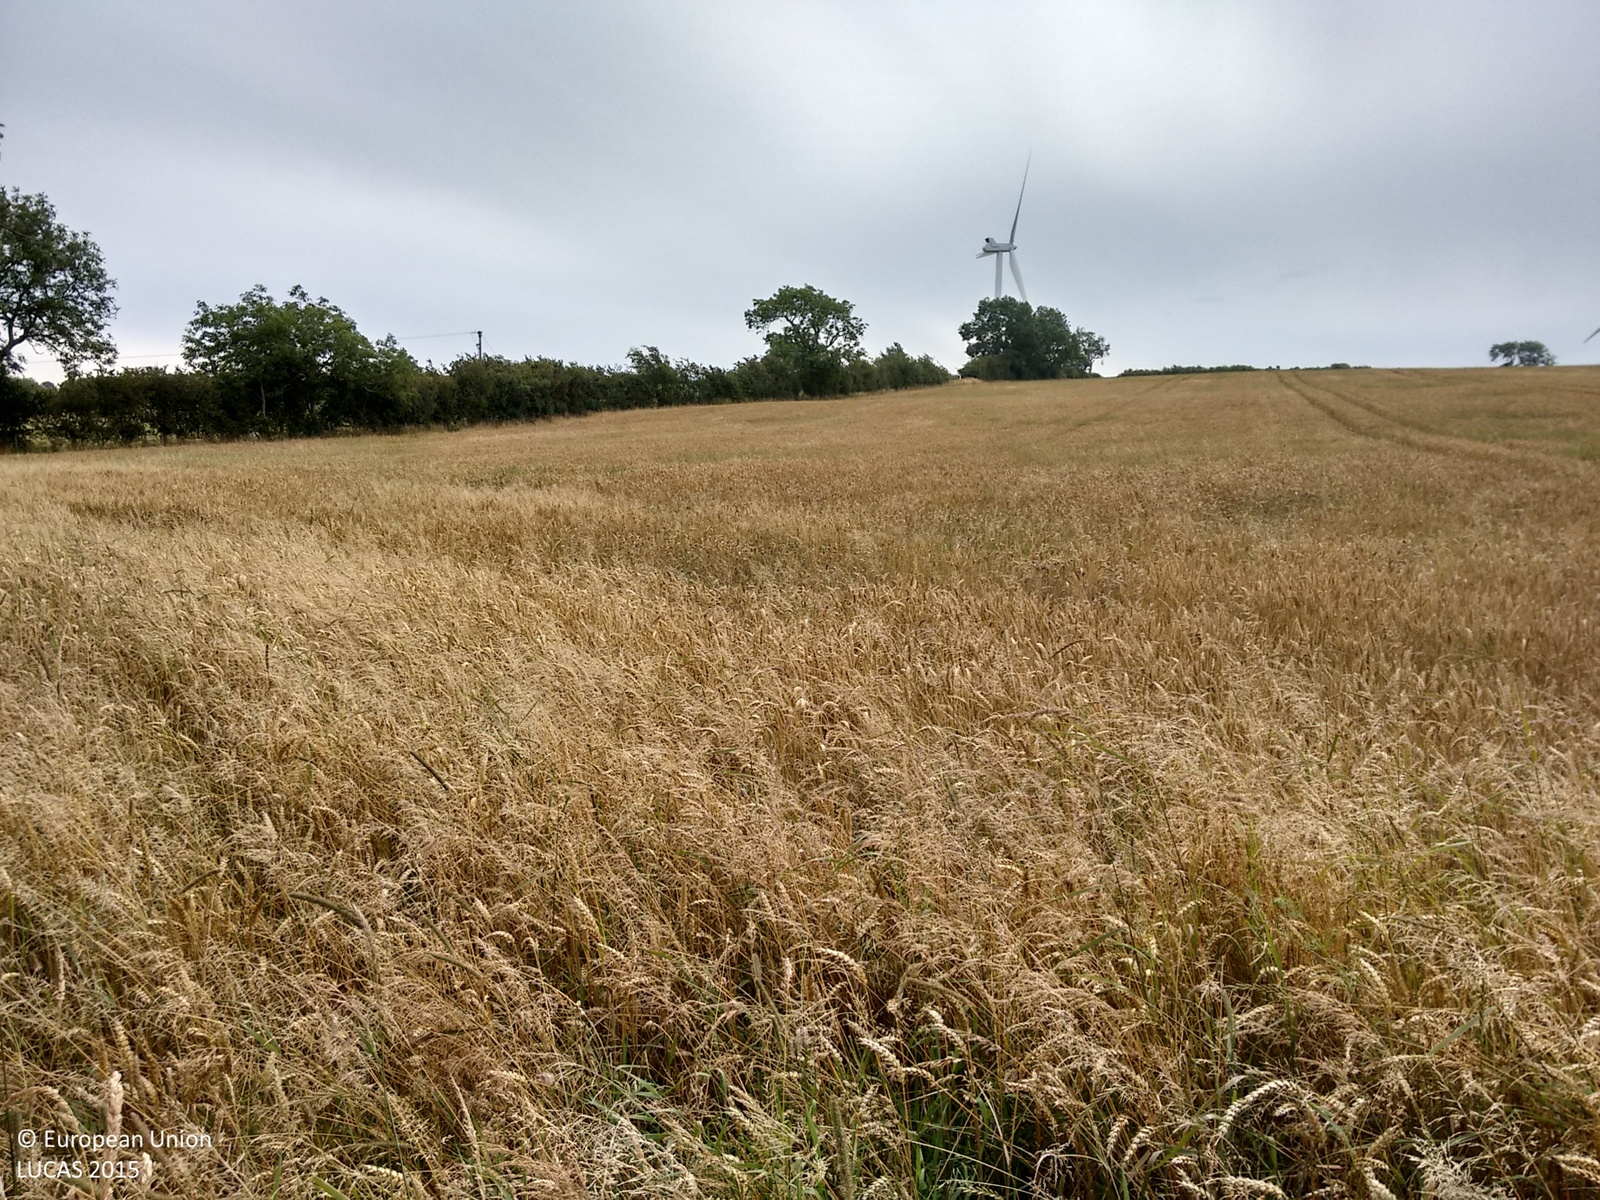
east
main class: Grassland
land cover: Grassland without tree/shrub cover
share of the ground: > 75 %
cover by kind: herbaceous plants 100 %
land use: Agriculture (excluding fallow land and kitchen gardens)
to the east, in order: Abandoned hedges; Fences; Common wheat; Abandoned hedges; Grassland without tree/shrub cover; Electric lines; Grassland without tree/shrub cover
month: August
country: GB
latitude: 54.7160
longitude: -3.3827
